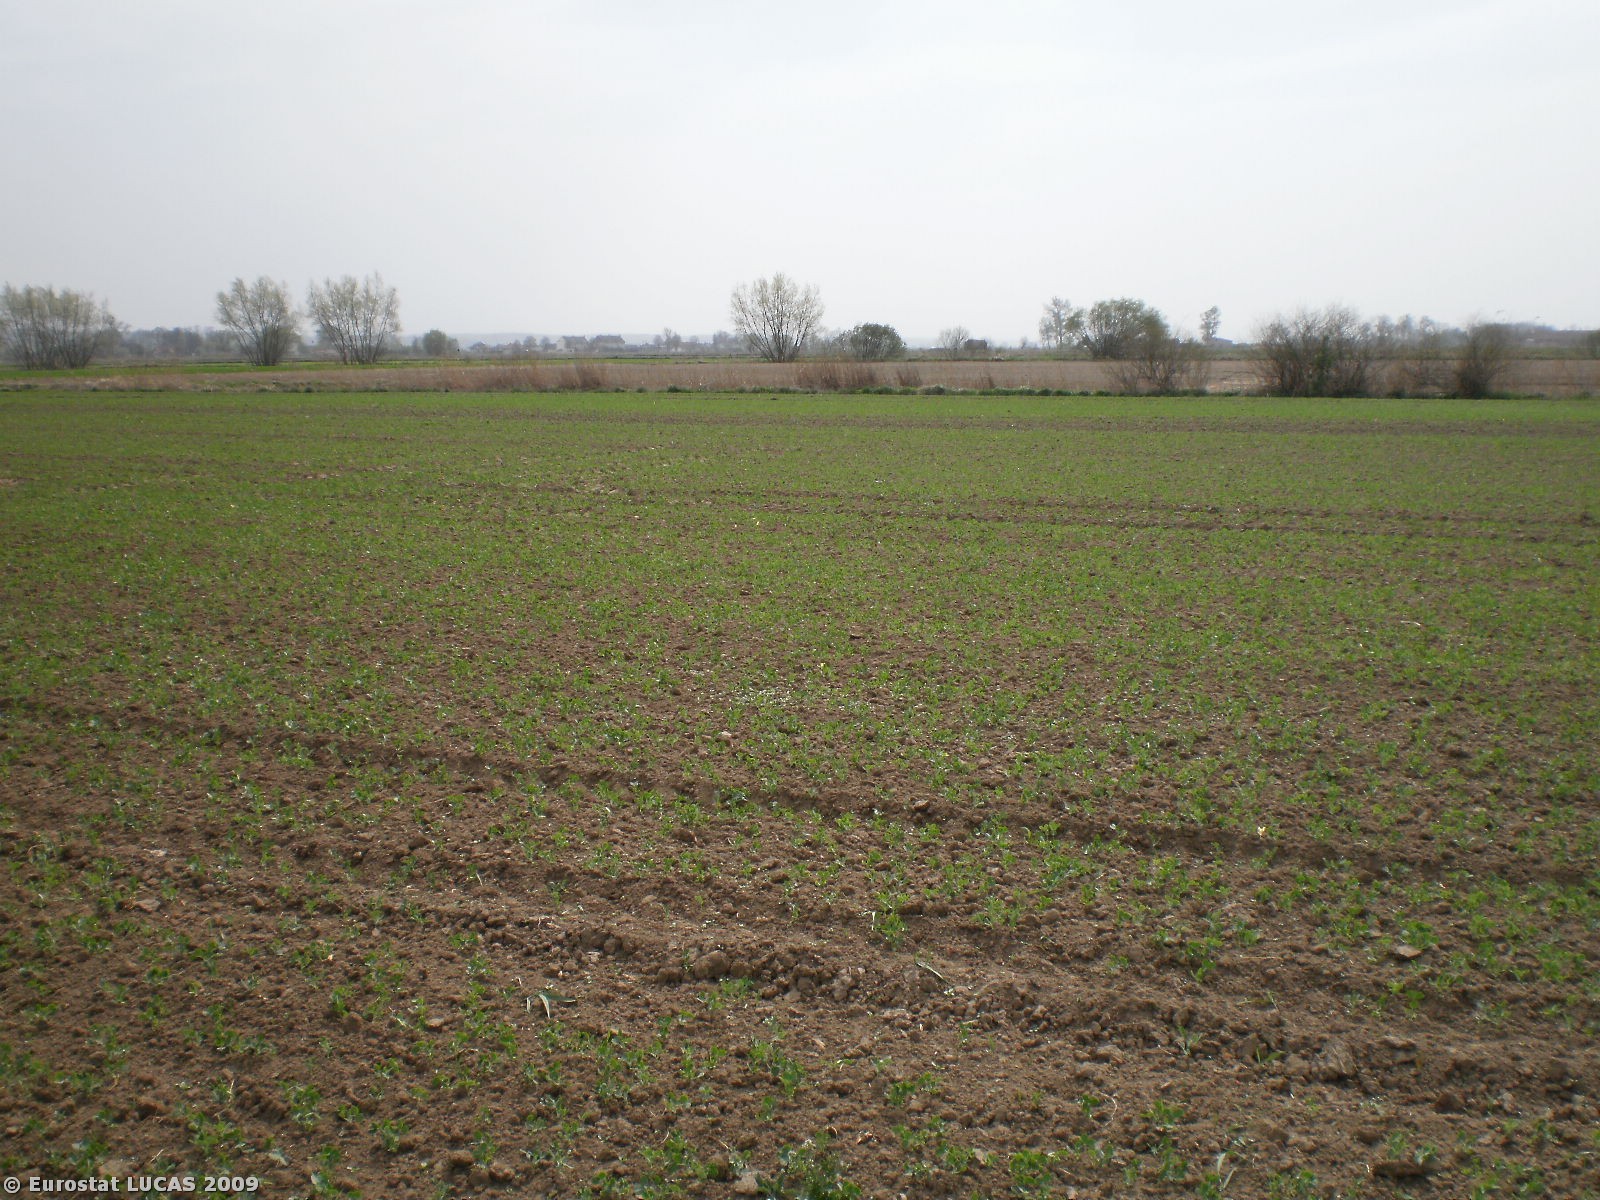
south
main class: Cropland
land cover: Dry pulses
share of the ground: 10 - 25 %
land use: Agriculture (excluding fallow land and kitchen gardens)
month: April
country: PL
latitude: 53.7437
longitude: 18.8912
